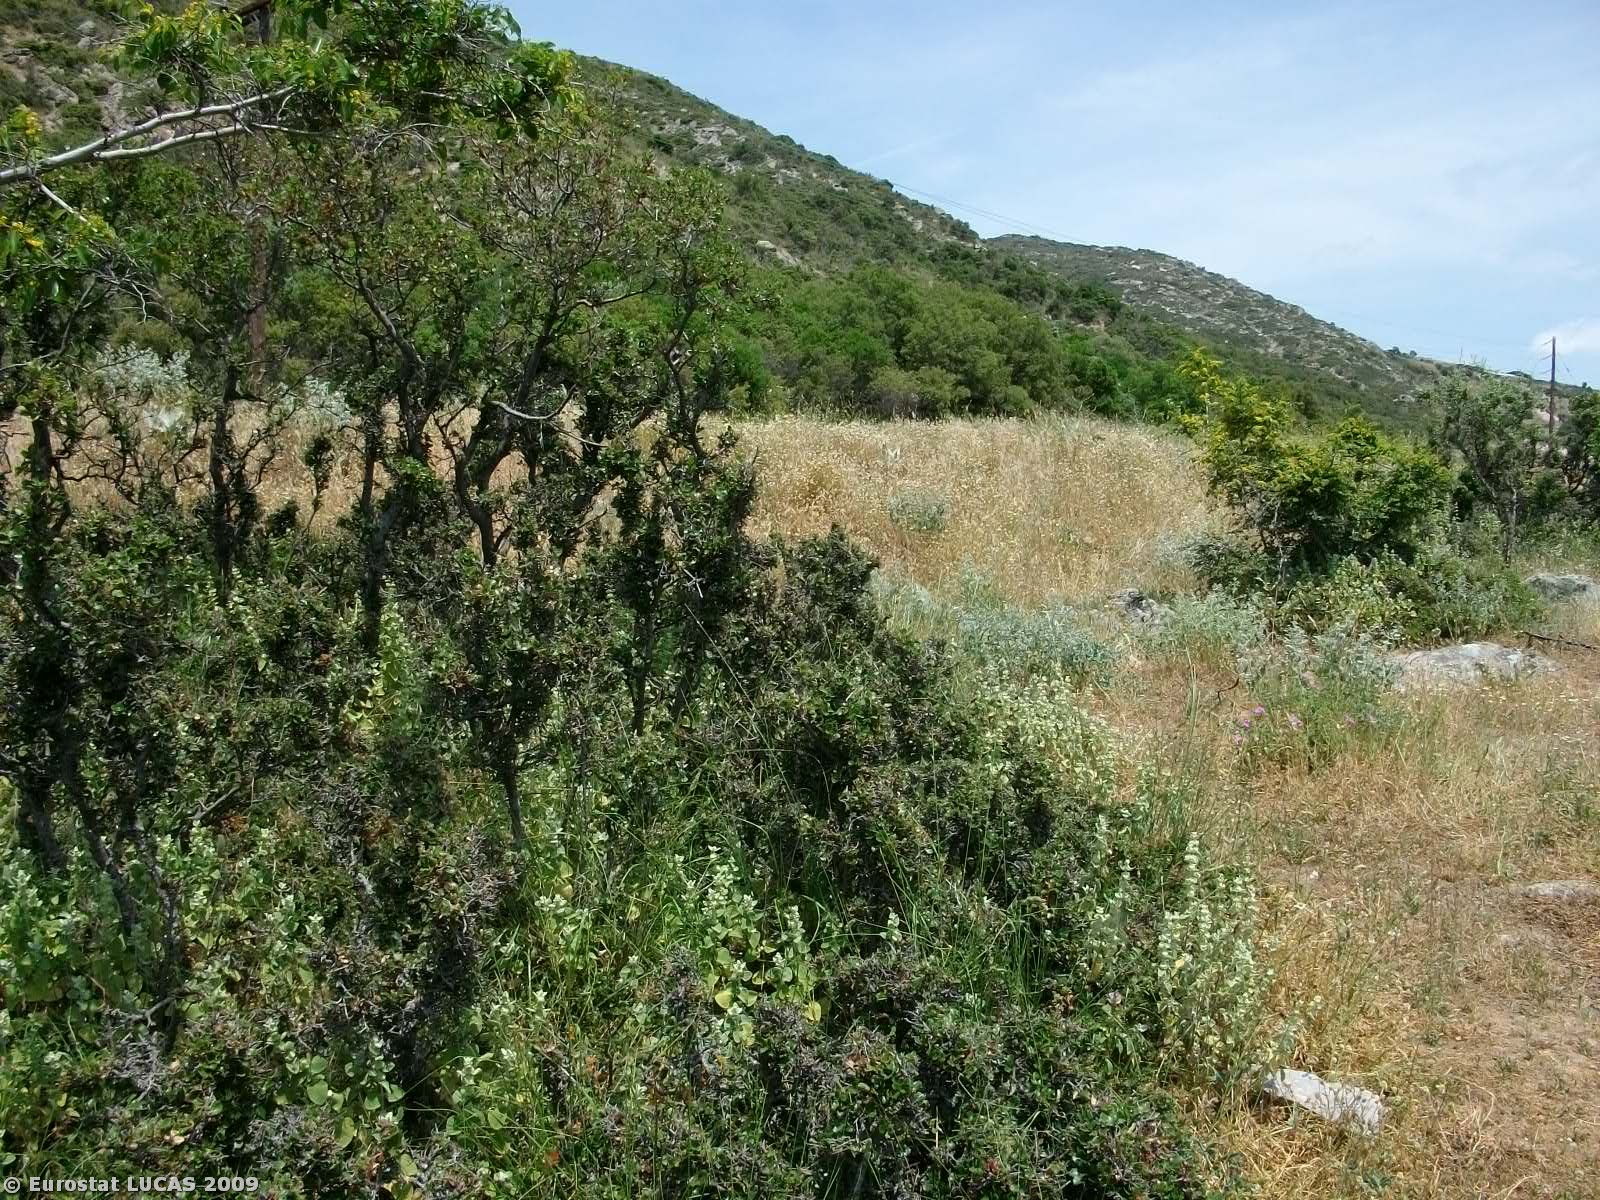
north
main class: Grassland
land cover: Grassland with sparse tree/shrub cover
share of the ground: > 75 %
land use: Agriculture (excluding fallow land and kitchen gardens)
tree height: < 5 m
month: May
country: GR
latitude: 39.7788
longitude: 22.6148
